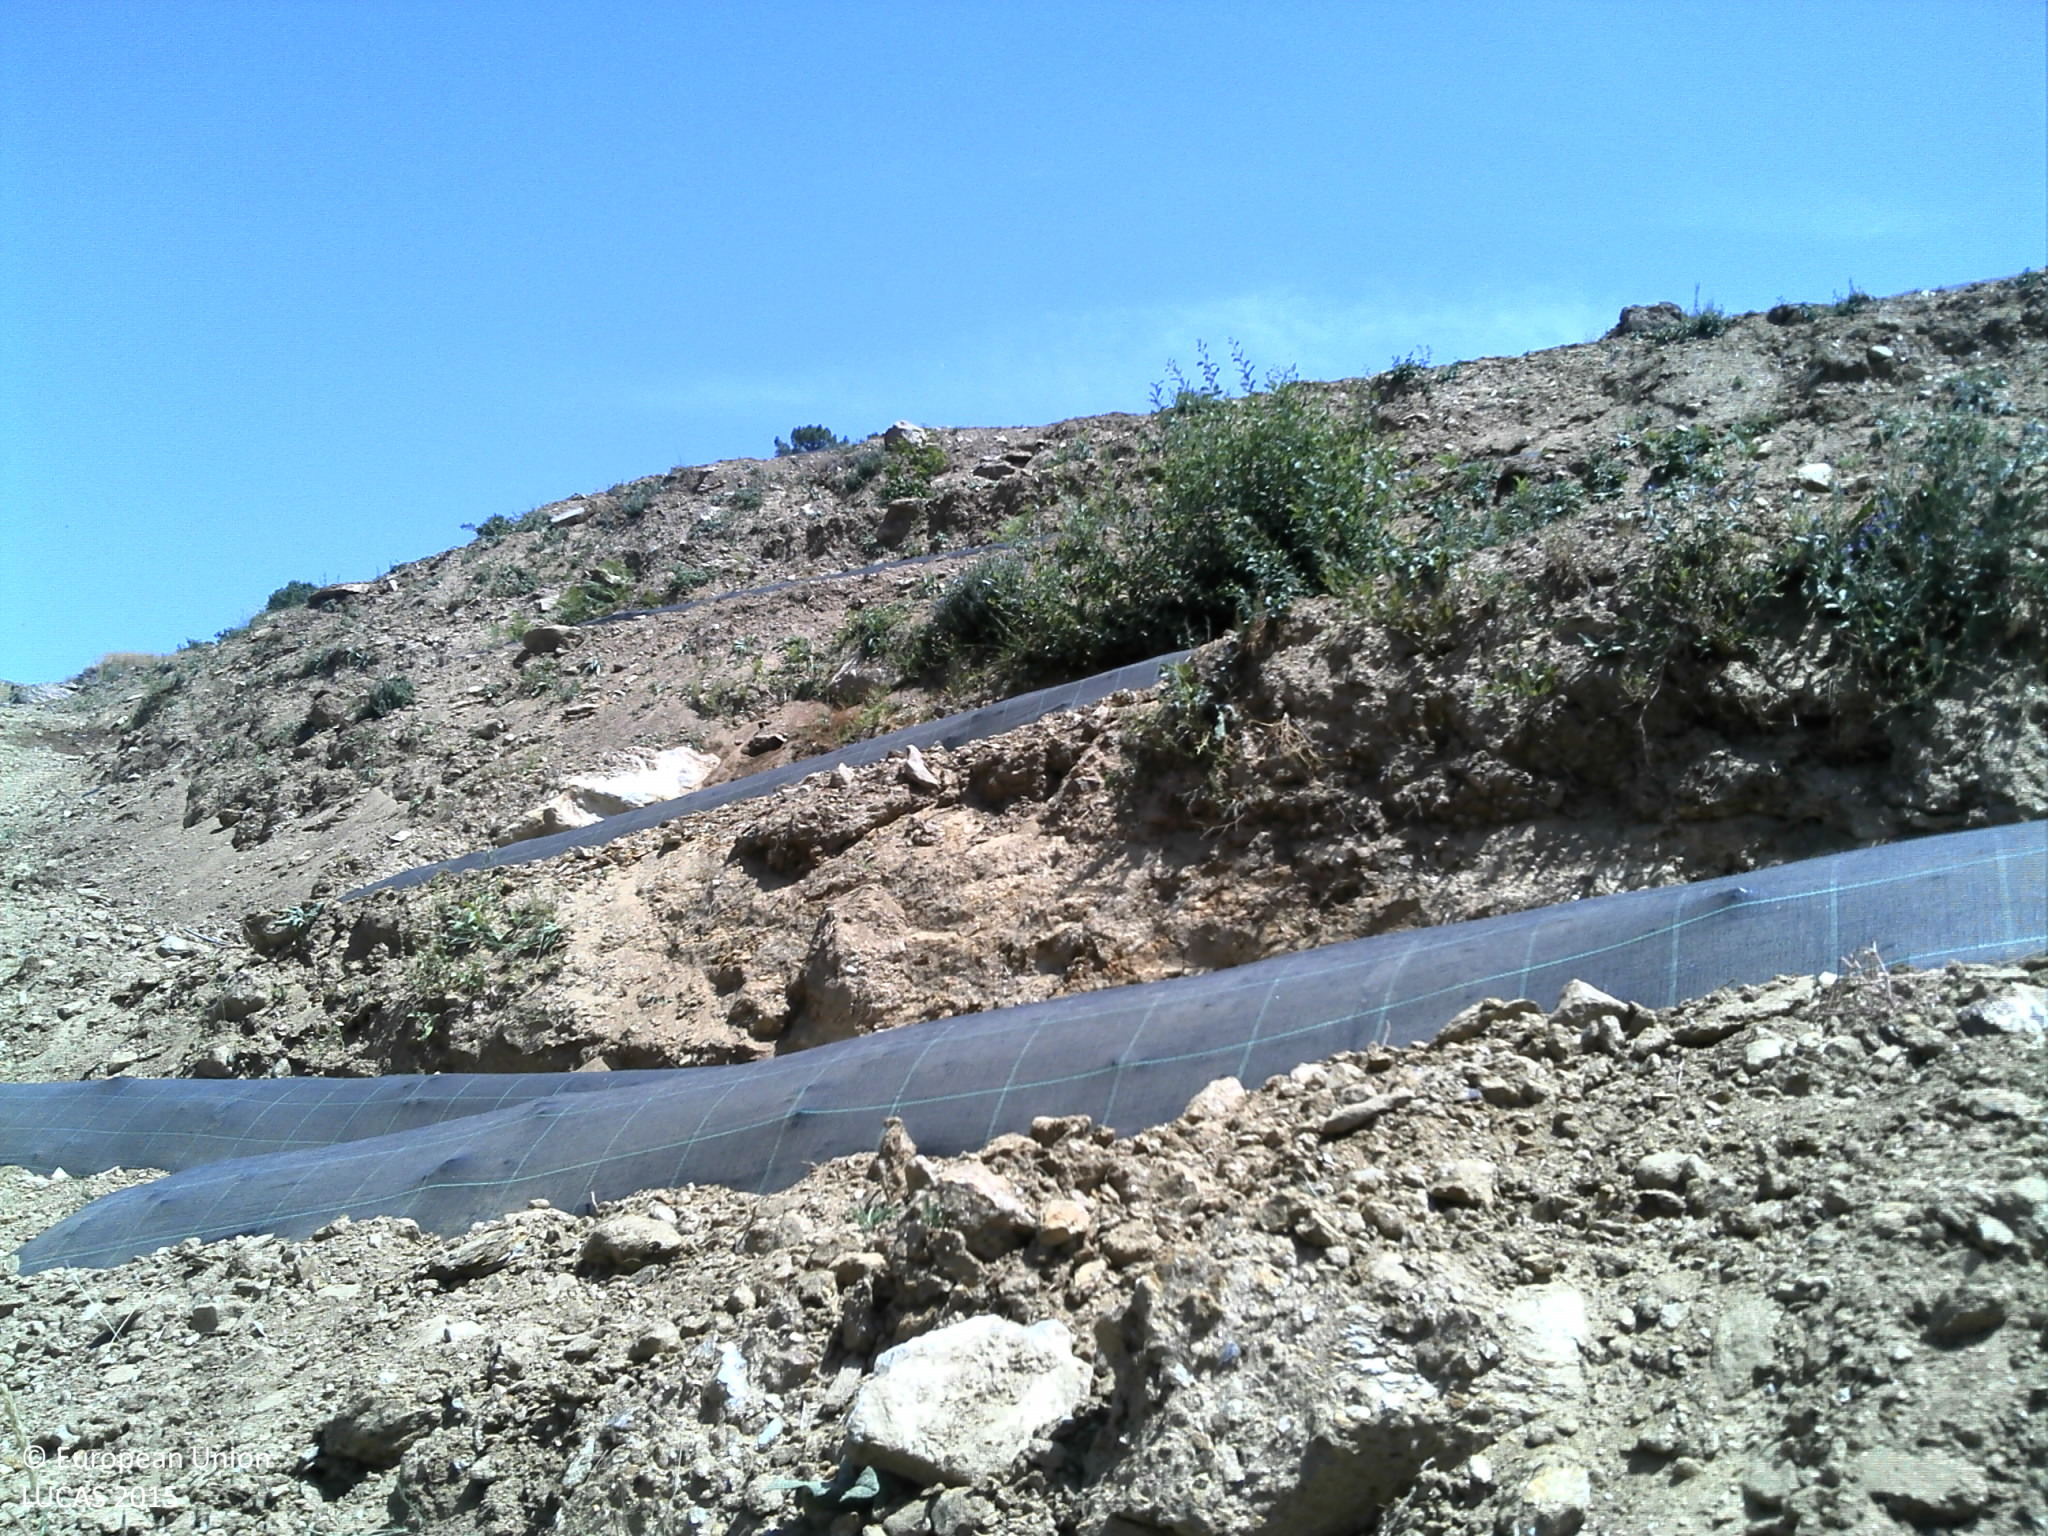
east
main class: Grassland
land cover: Spontaneously vegetated surfaces
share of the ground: < 10 %
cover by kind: unconsolidated bare surface 90 %, herbaceous plants 10 %
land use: Fallow land
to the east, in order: Spontaneously vegetated surfaces; Other fruit trees and berries; Grass margins; Tracks; Nuts trees; Fences; Shruby margins; Dry stone walls; Nuts trees; Grassland without tree/shrub cover
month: July
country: PT
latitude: 41.0592
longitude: -7.4073
